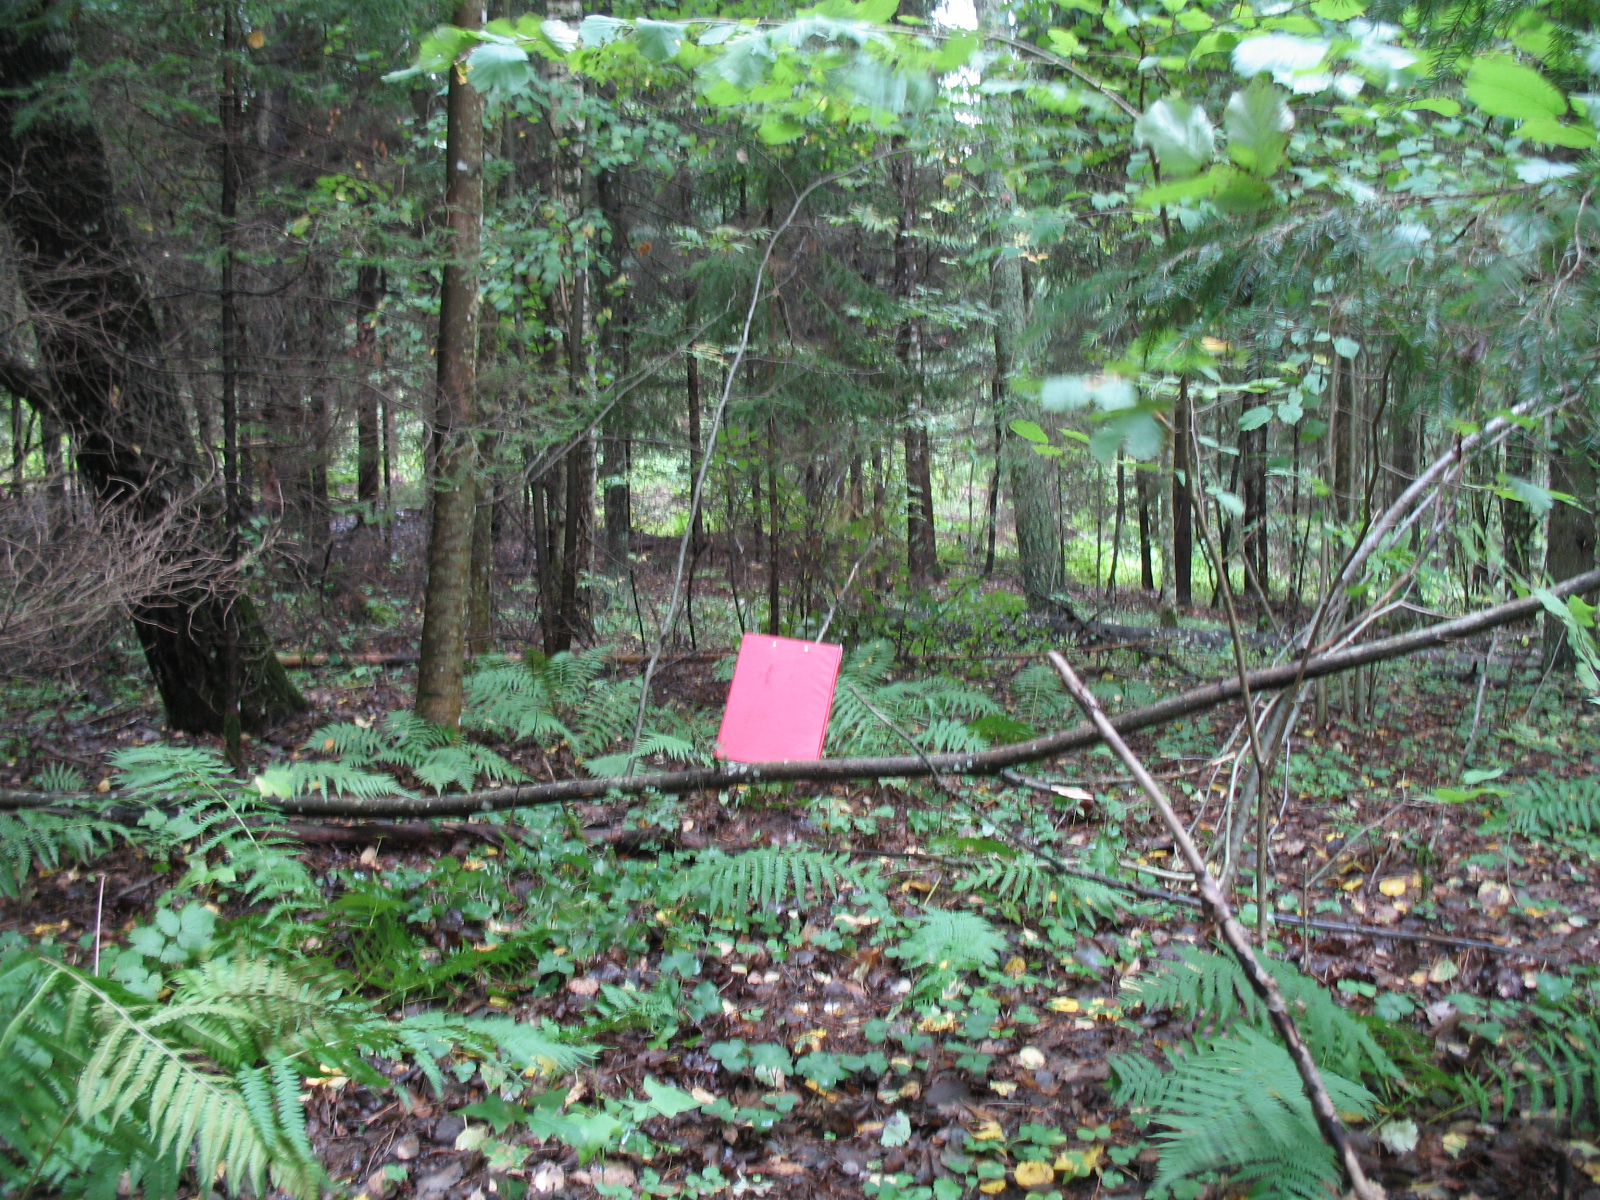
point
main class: Woodland
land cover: Spruce dominated mixed woodland
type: hemiboreal forest and nemoral coniferous forest and mixed broadleaved-coniferous forest
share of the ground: > 75 %
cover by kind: broadleaved forest trees 45 %, coniferous forest trees 40 %, herbaceous plants 10 %, unconsolidated bare surface 5 %
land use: Forestry
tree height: > 5 m
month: September
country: LV
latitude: 56.1047
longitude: 25.9056
